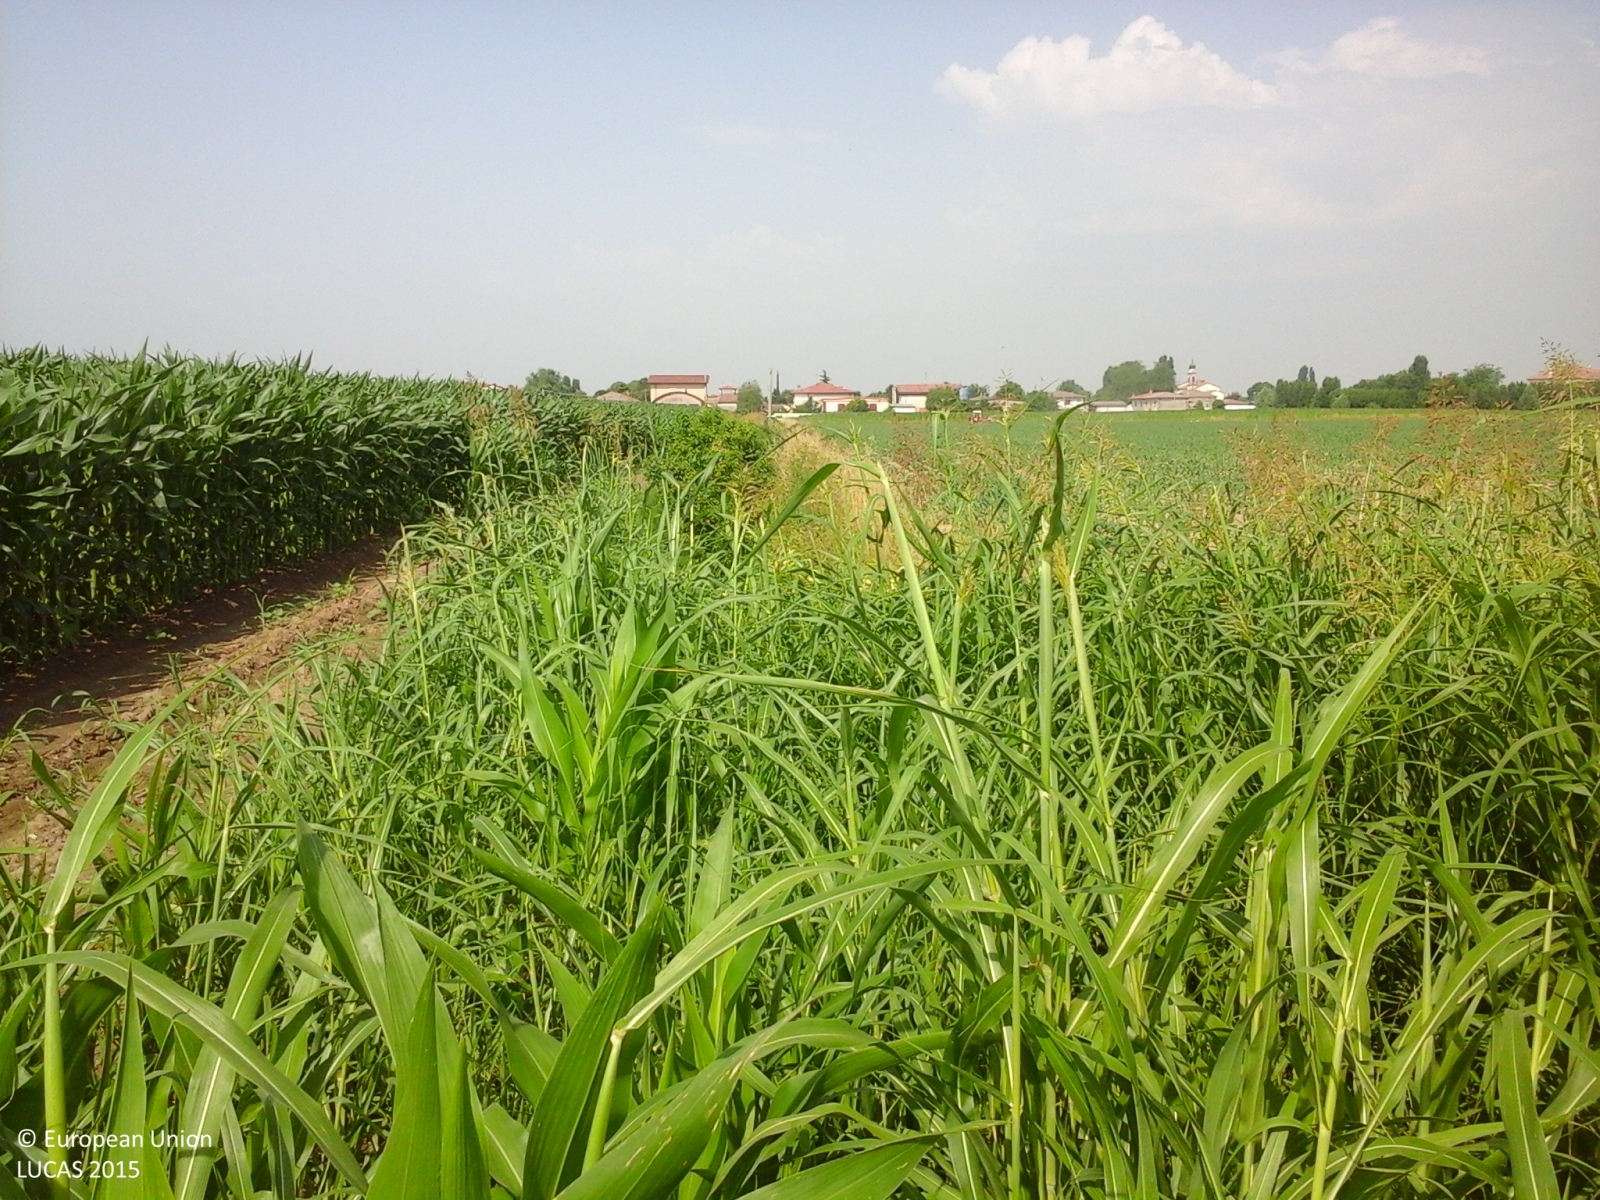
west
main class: Cropland
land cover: Maize
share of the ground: > 75 %
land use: Agriculture (excluding fallow land and kitchen gardens)
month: June
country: IT
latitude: 45.2102
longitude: 11.1057
